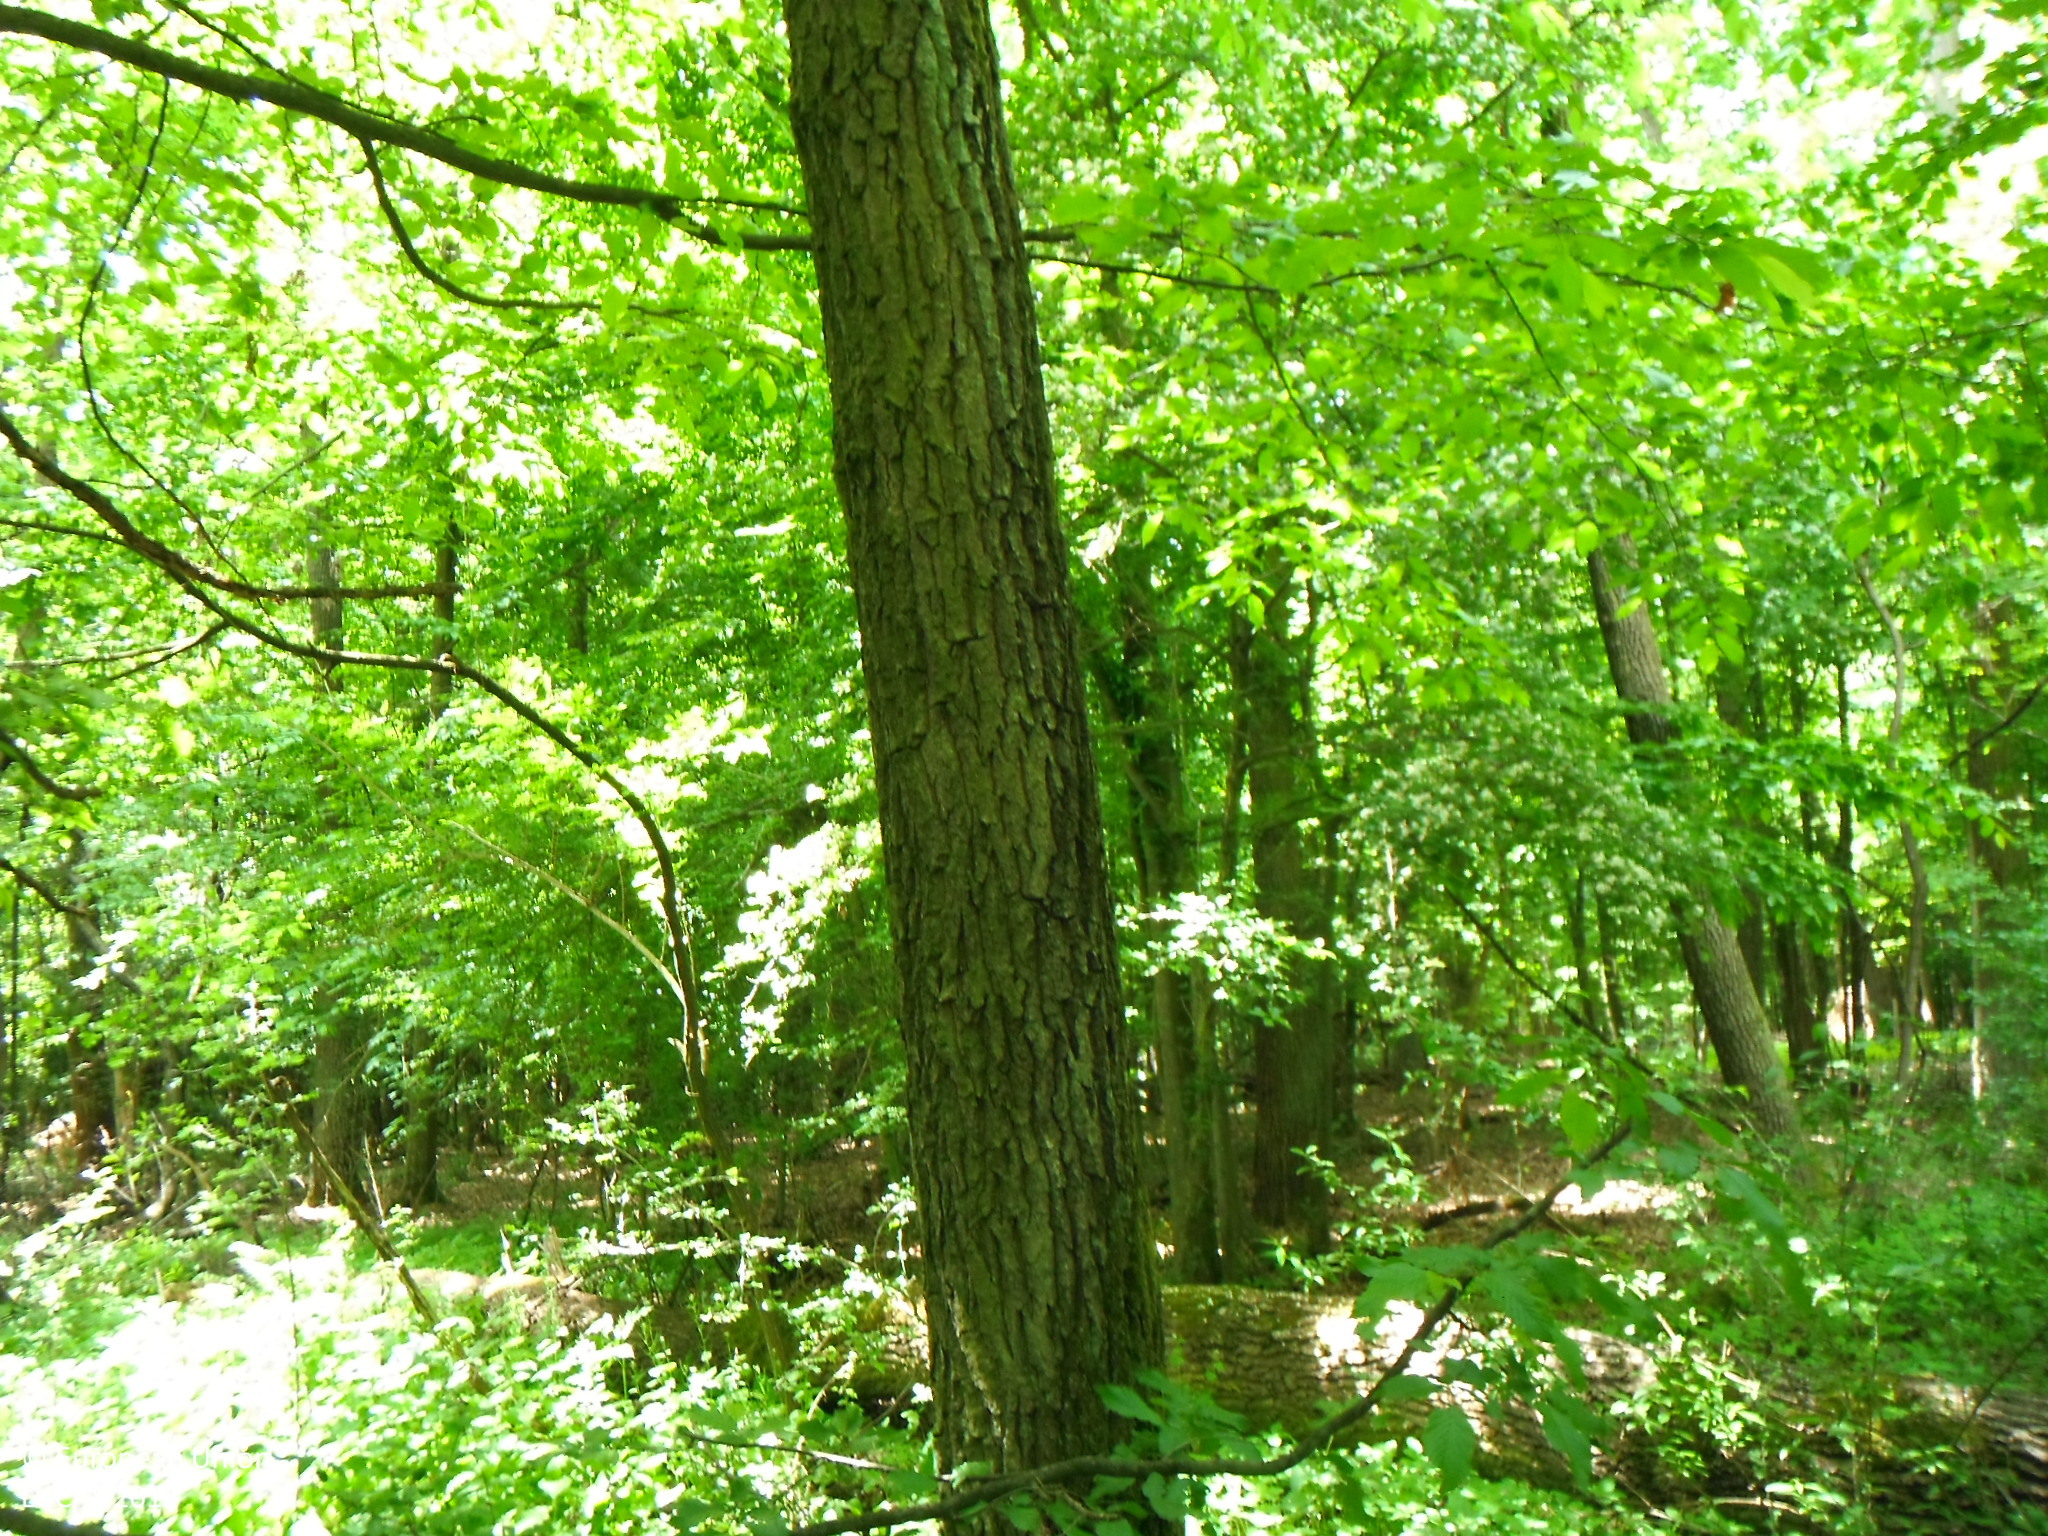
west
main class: Woodland
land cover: Broadleaved woodland
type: acidophilous oak and oak-birch forest
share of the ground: > 75 %
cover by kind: broadleaved forest trees 90 %, herbaceous plants 10 %
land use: Forestry
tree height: > 5 m
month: May
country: SK
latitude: 48.6237
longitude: 21.0992
